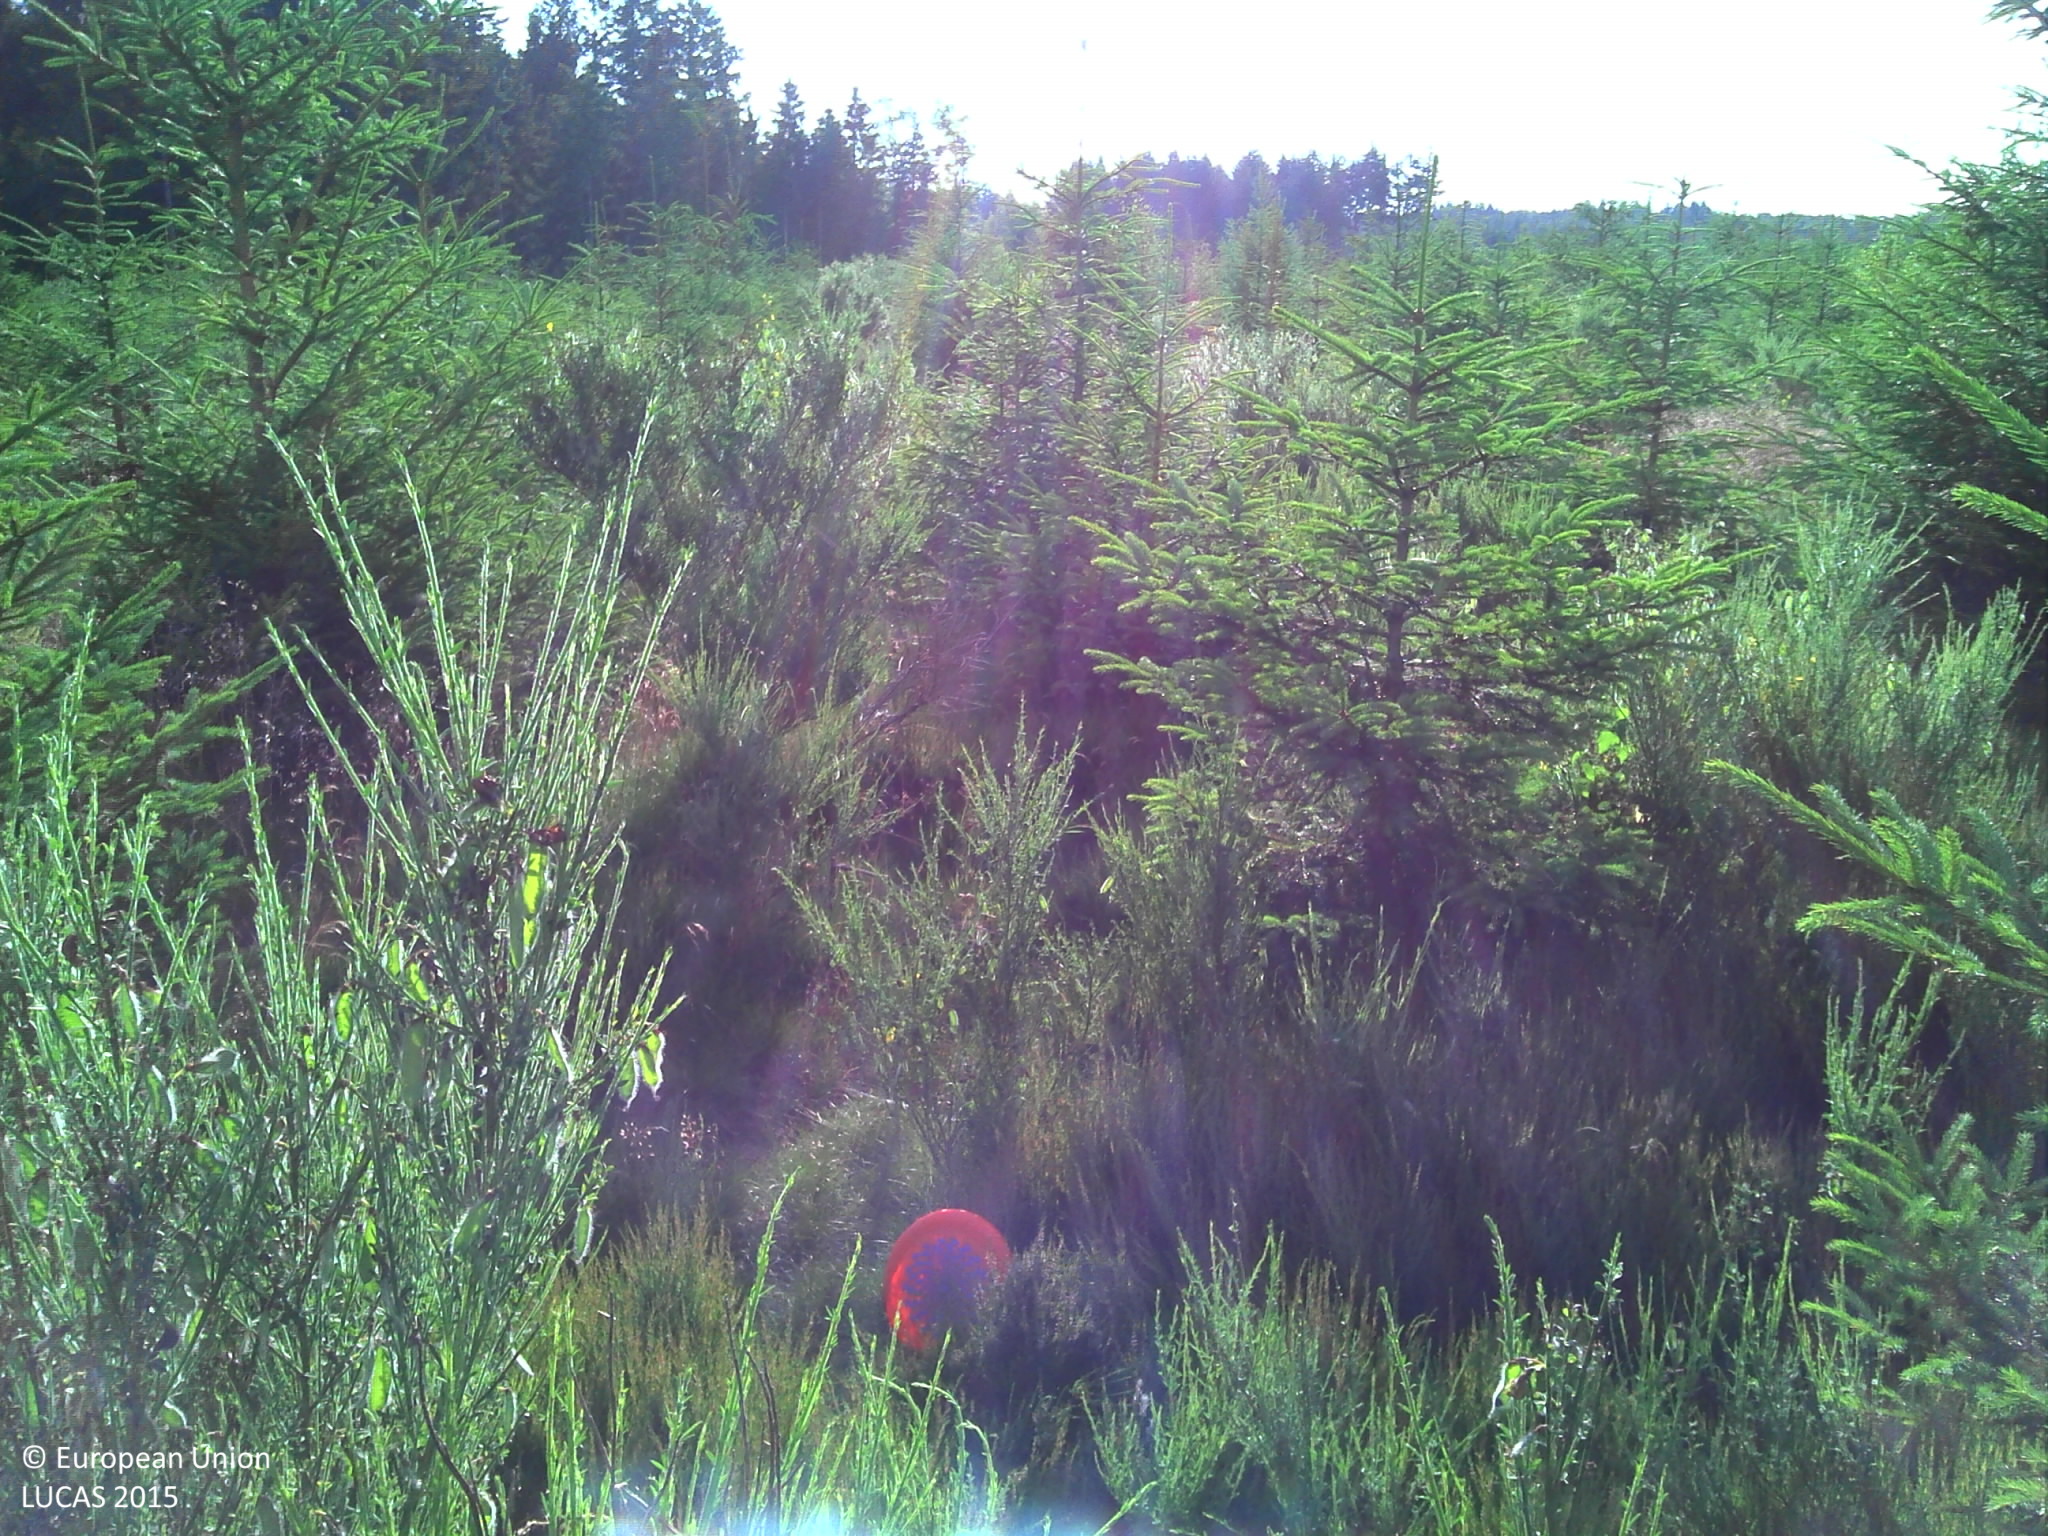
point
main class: Cropland
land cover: Nurseries
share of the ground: > 75 %
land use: Forestry
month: July
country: BE
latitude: 50.2322
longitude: 5.7790
